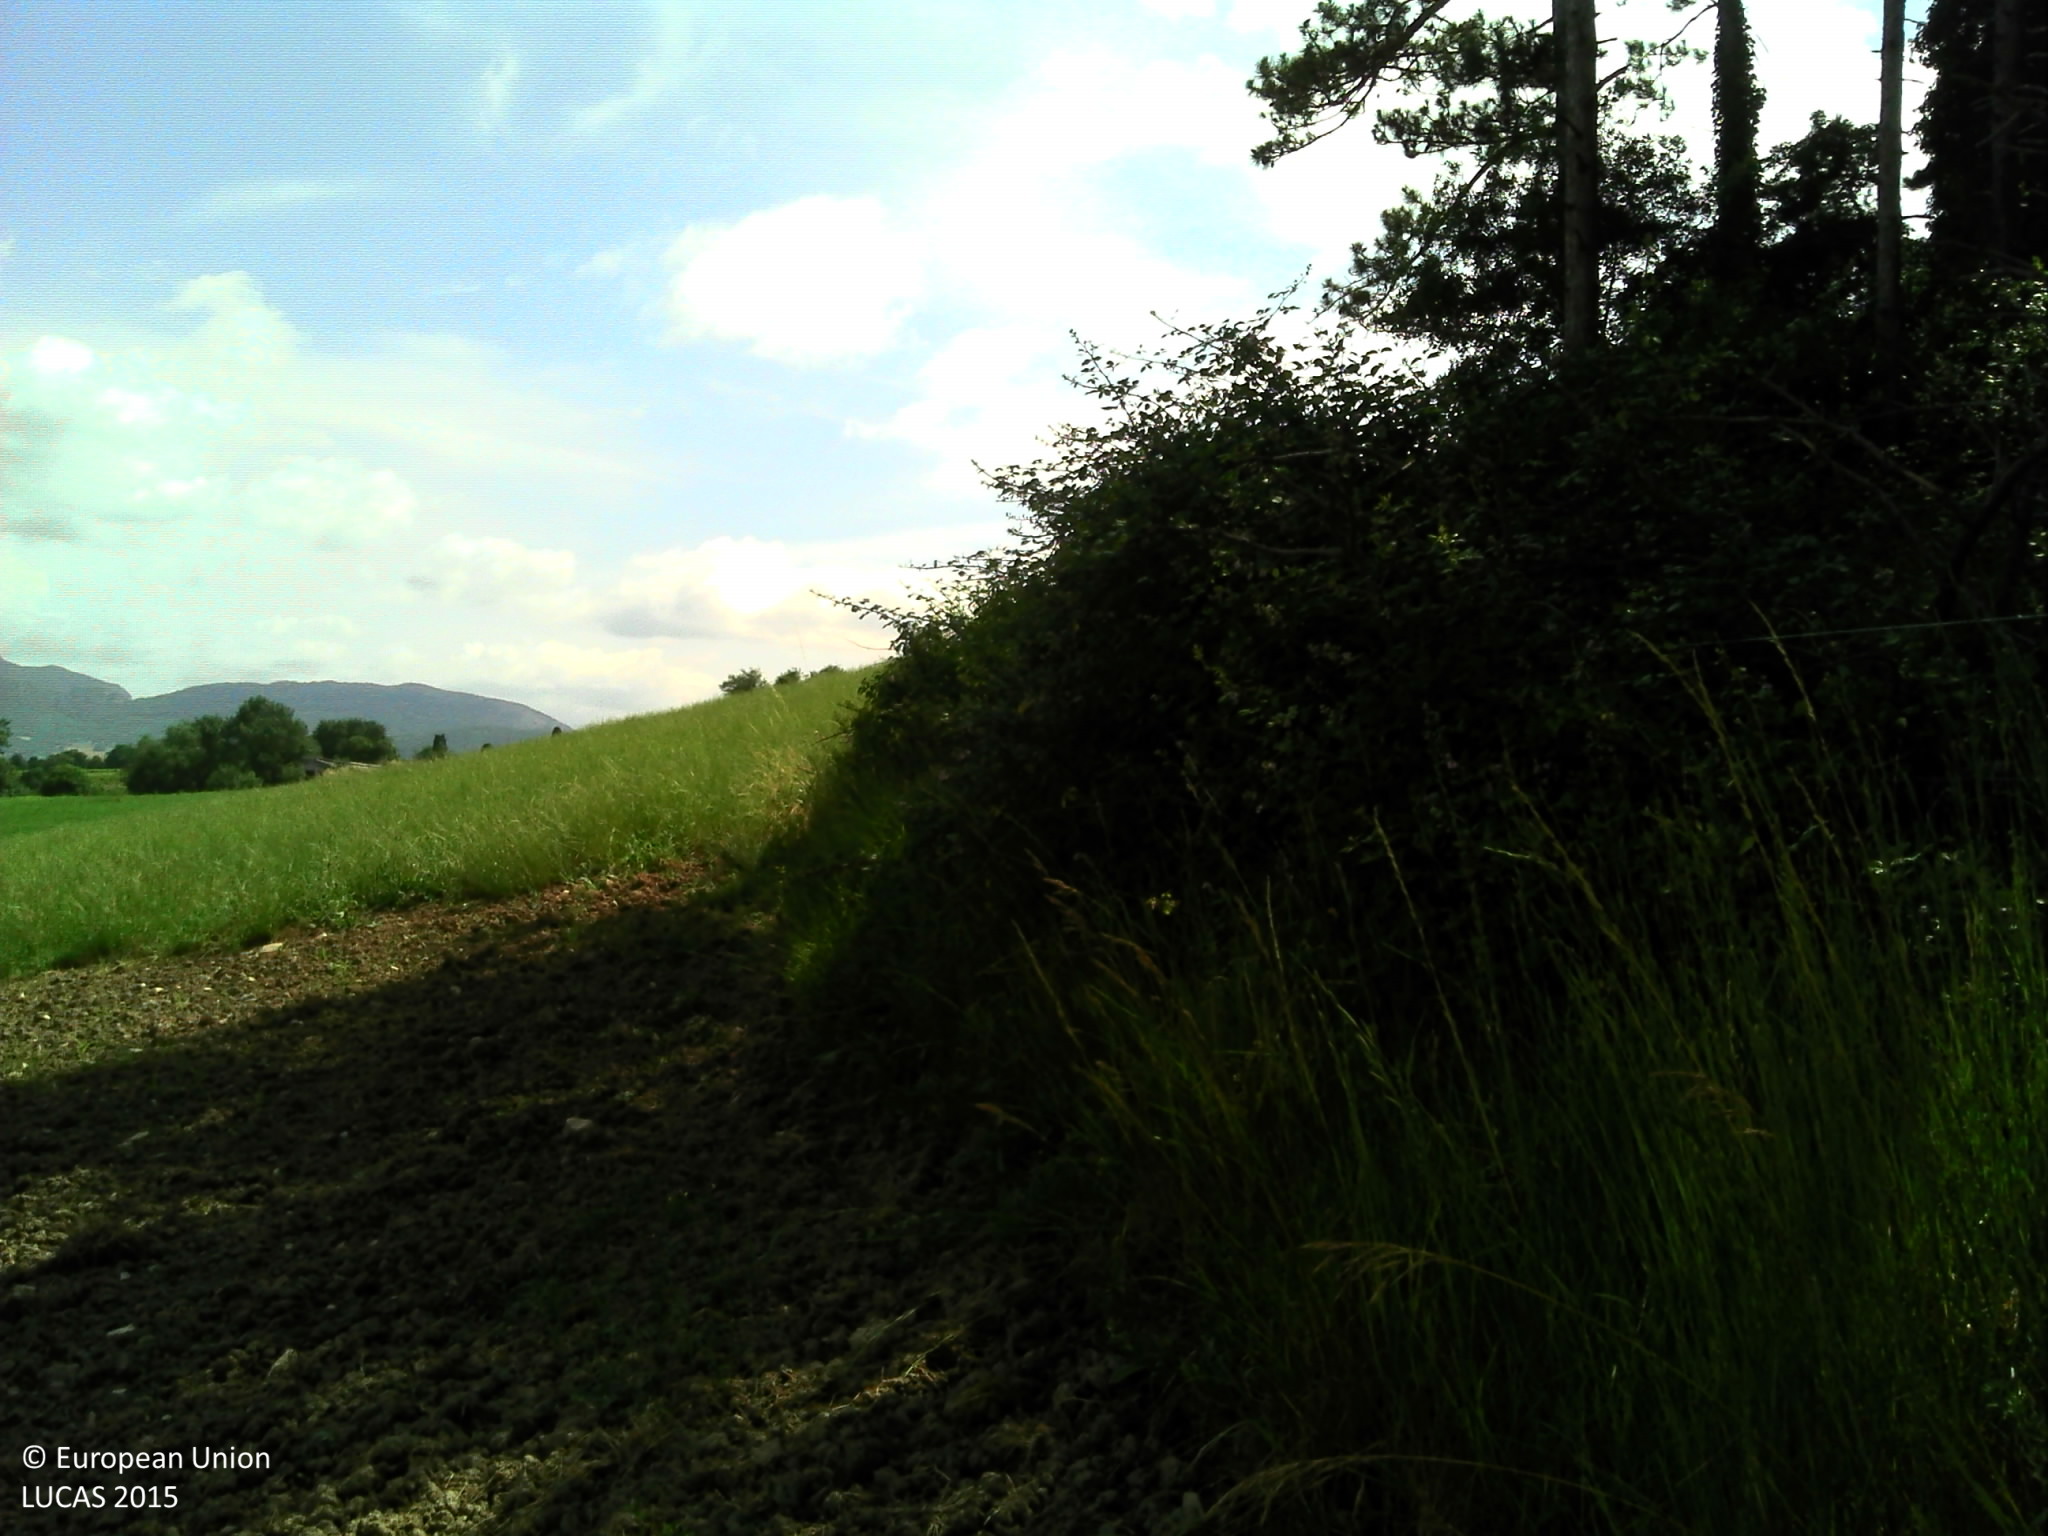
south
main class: Woodland
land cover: Pine dominated coniferous woodland
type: coniferous forest of the mediterranean region
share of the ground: > 75 %
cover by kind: coniferous forest trees 90 %, herbaceous plants 10 %
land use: Forestry
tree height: > 5 m
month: June
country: FR
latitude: 44.7403
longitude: 5.0937
